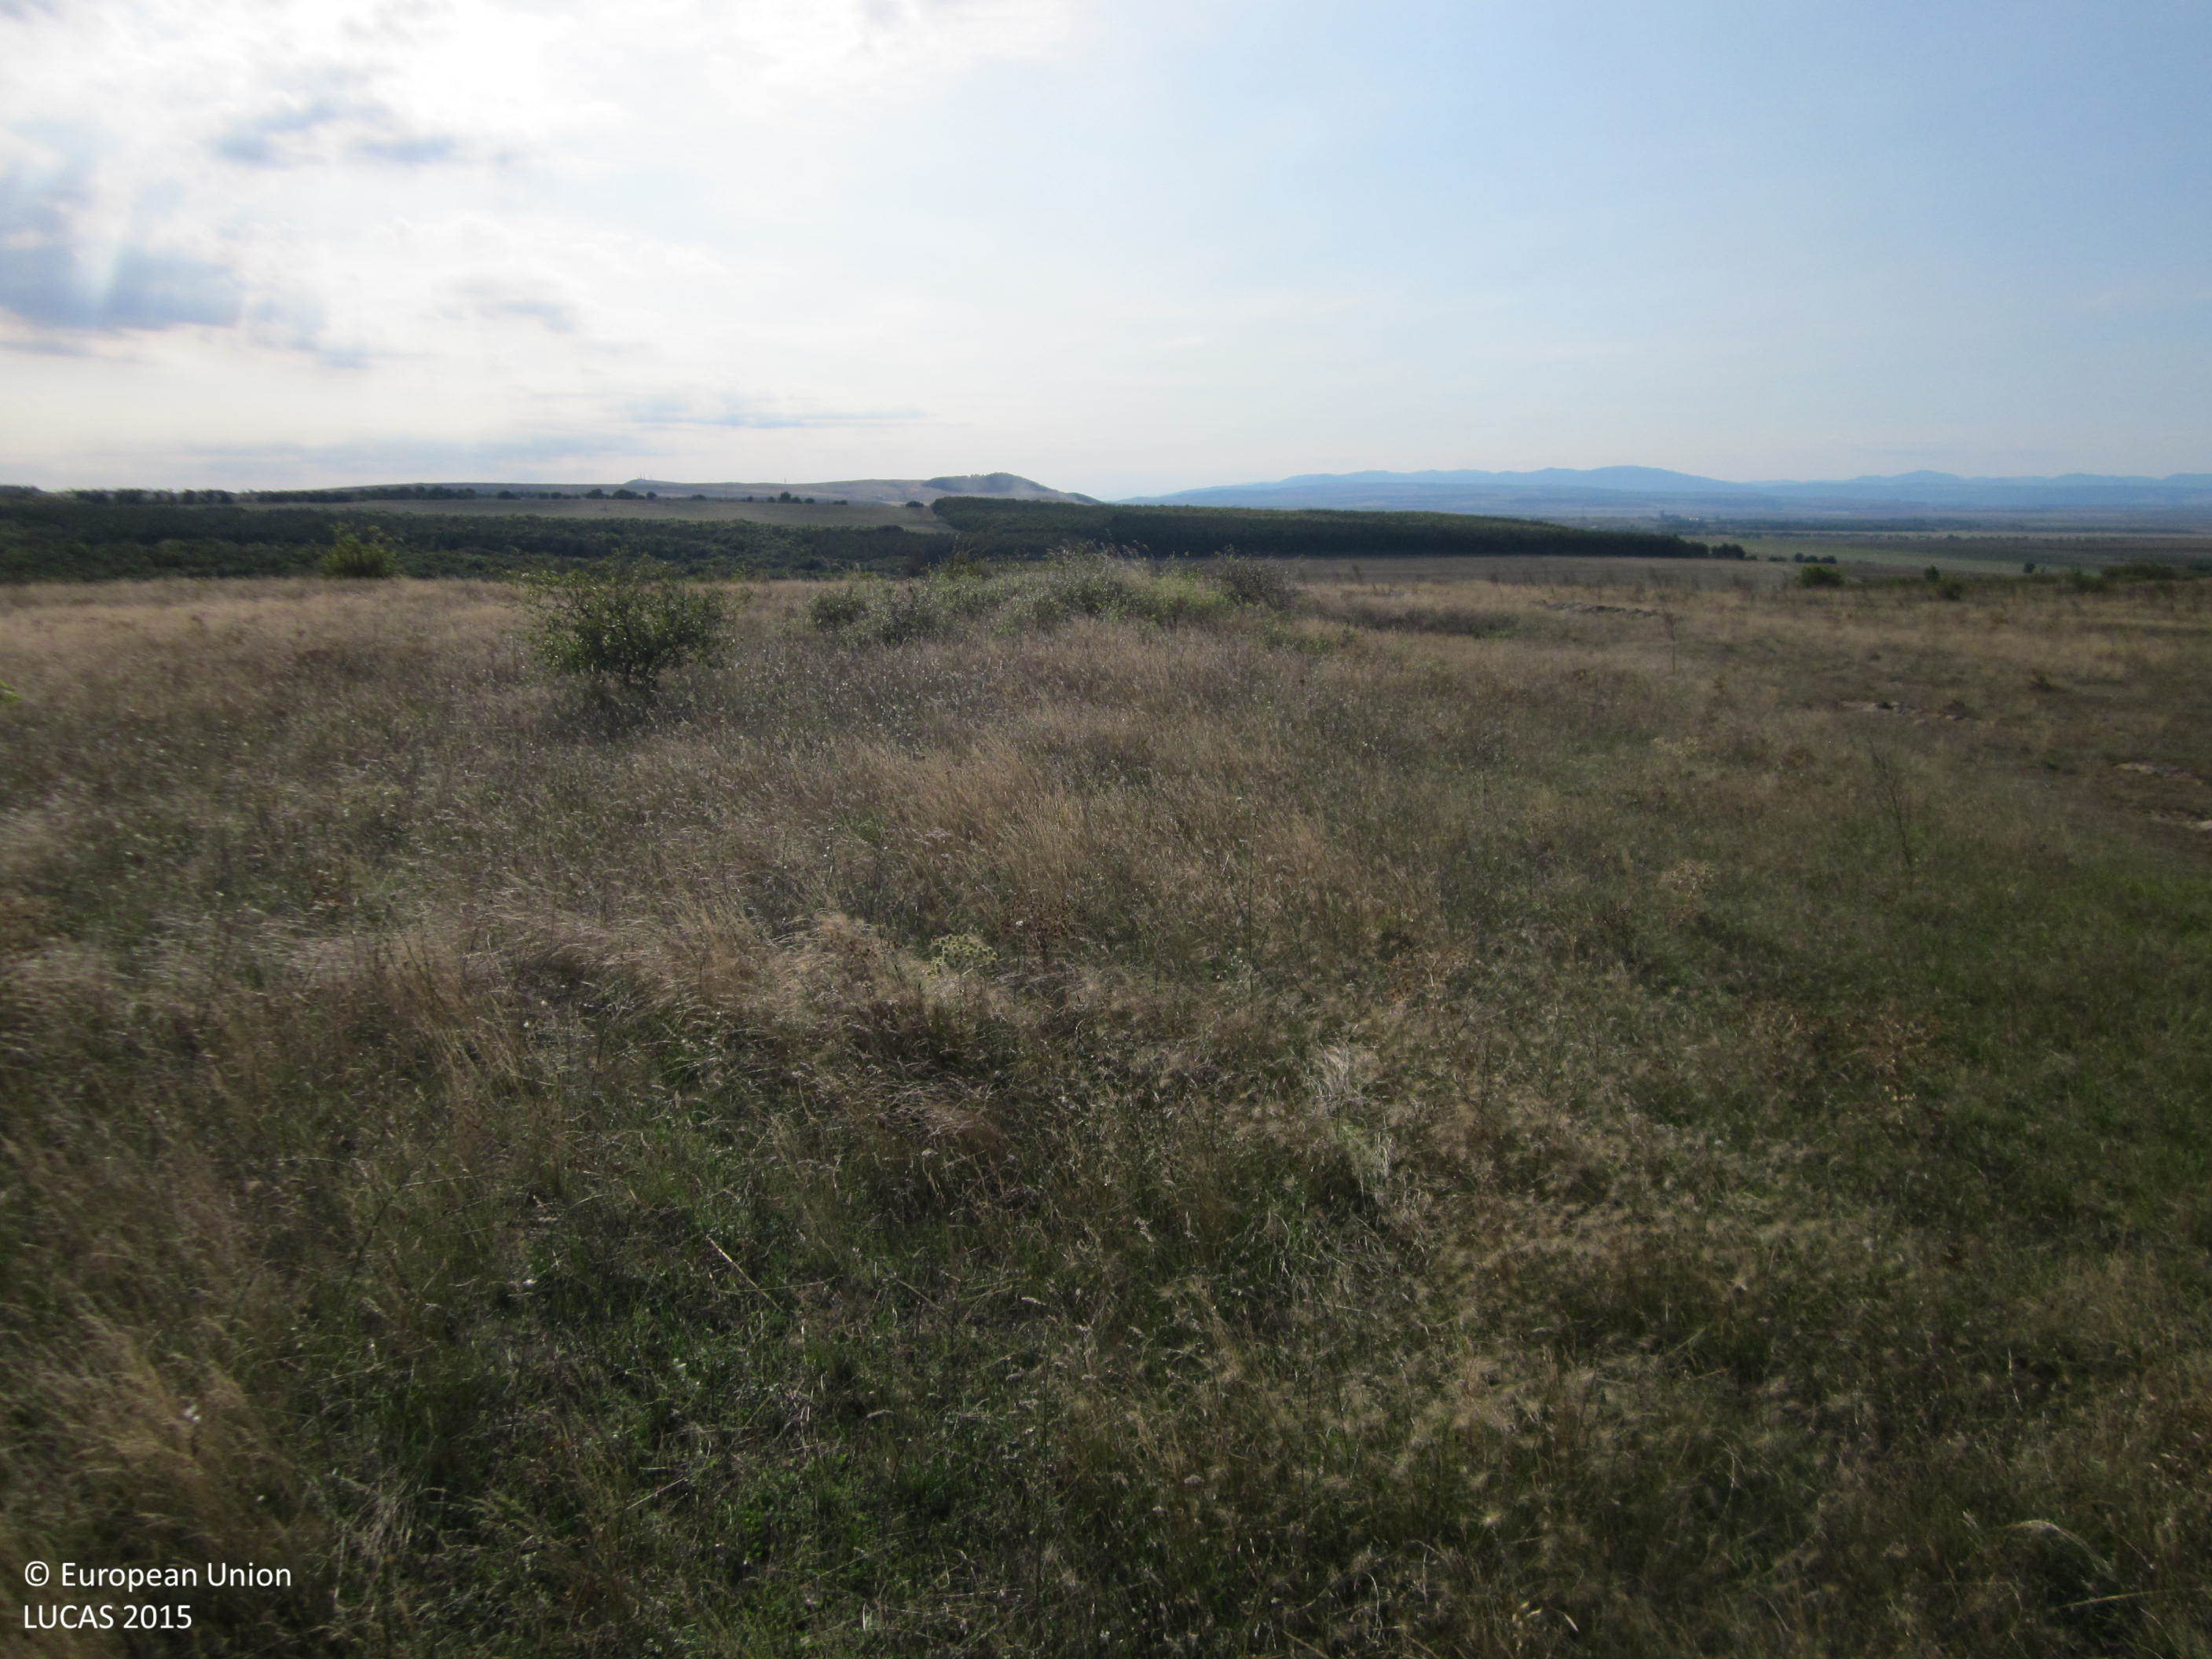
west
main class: Grassland
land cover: Grassland with sparse tree/shrub cover
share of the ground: > 75 %
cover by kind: herbaceous plants 90 %, broadleaved forest trees 5 %, shrubs 5 %
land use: Agriculture (excluding fallow land and kitchen gardens)
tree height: < 5 m
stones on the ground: < 10 %
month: September
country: BG
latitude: 42.6464
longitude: 27.0746
